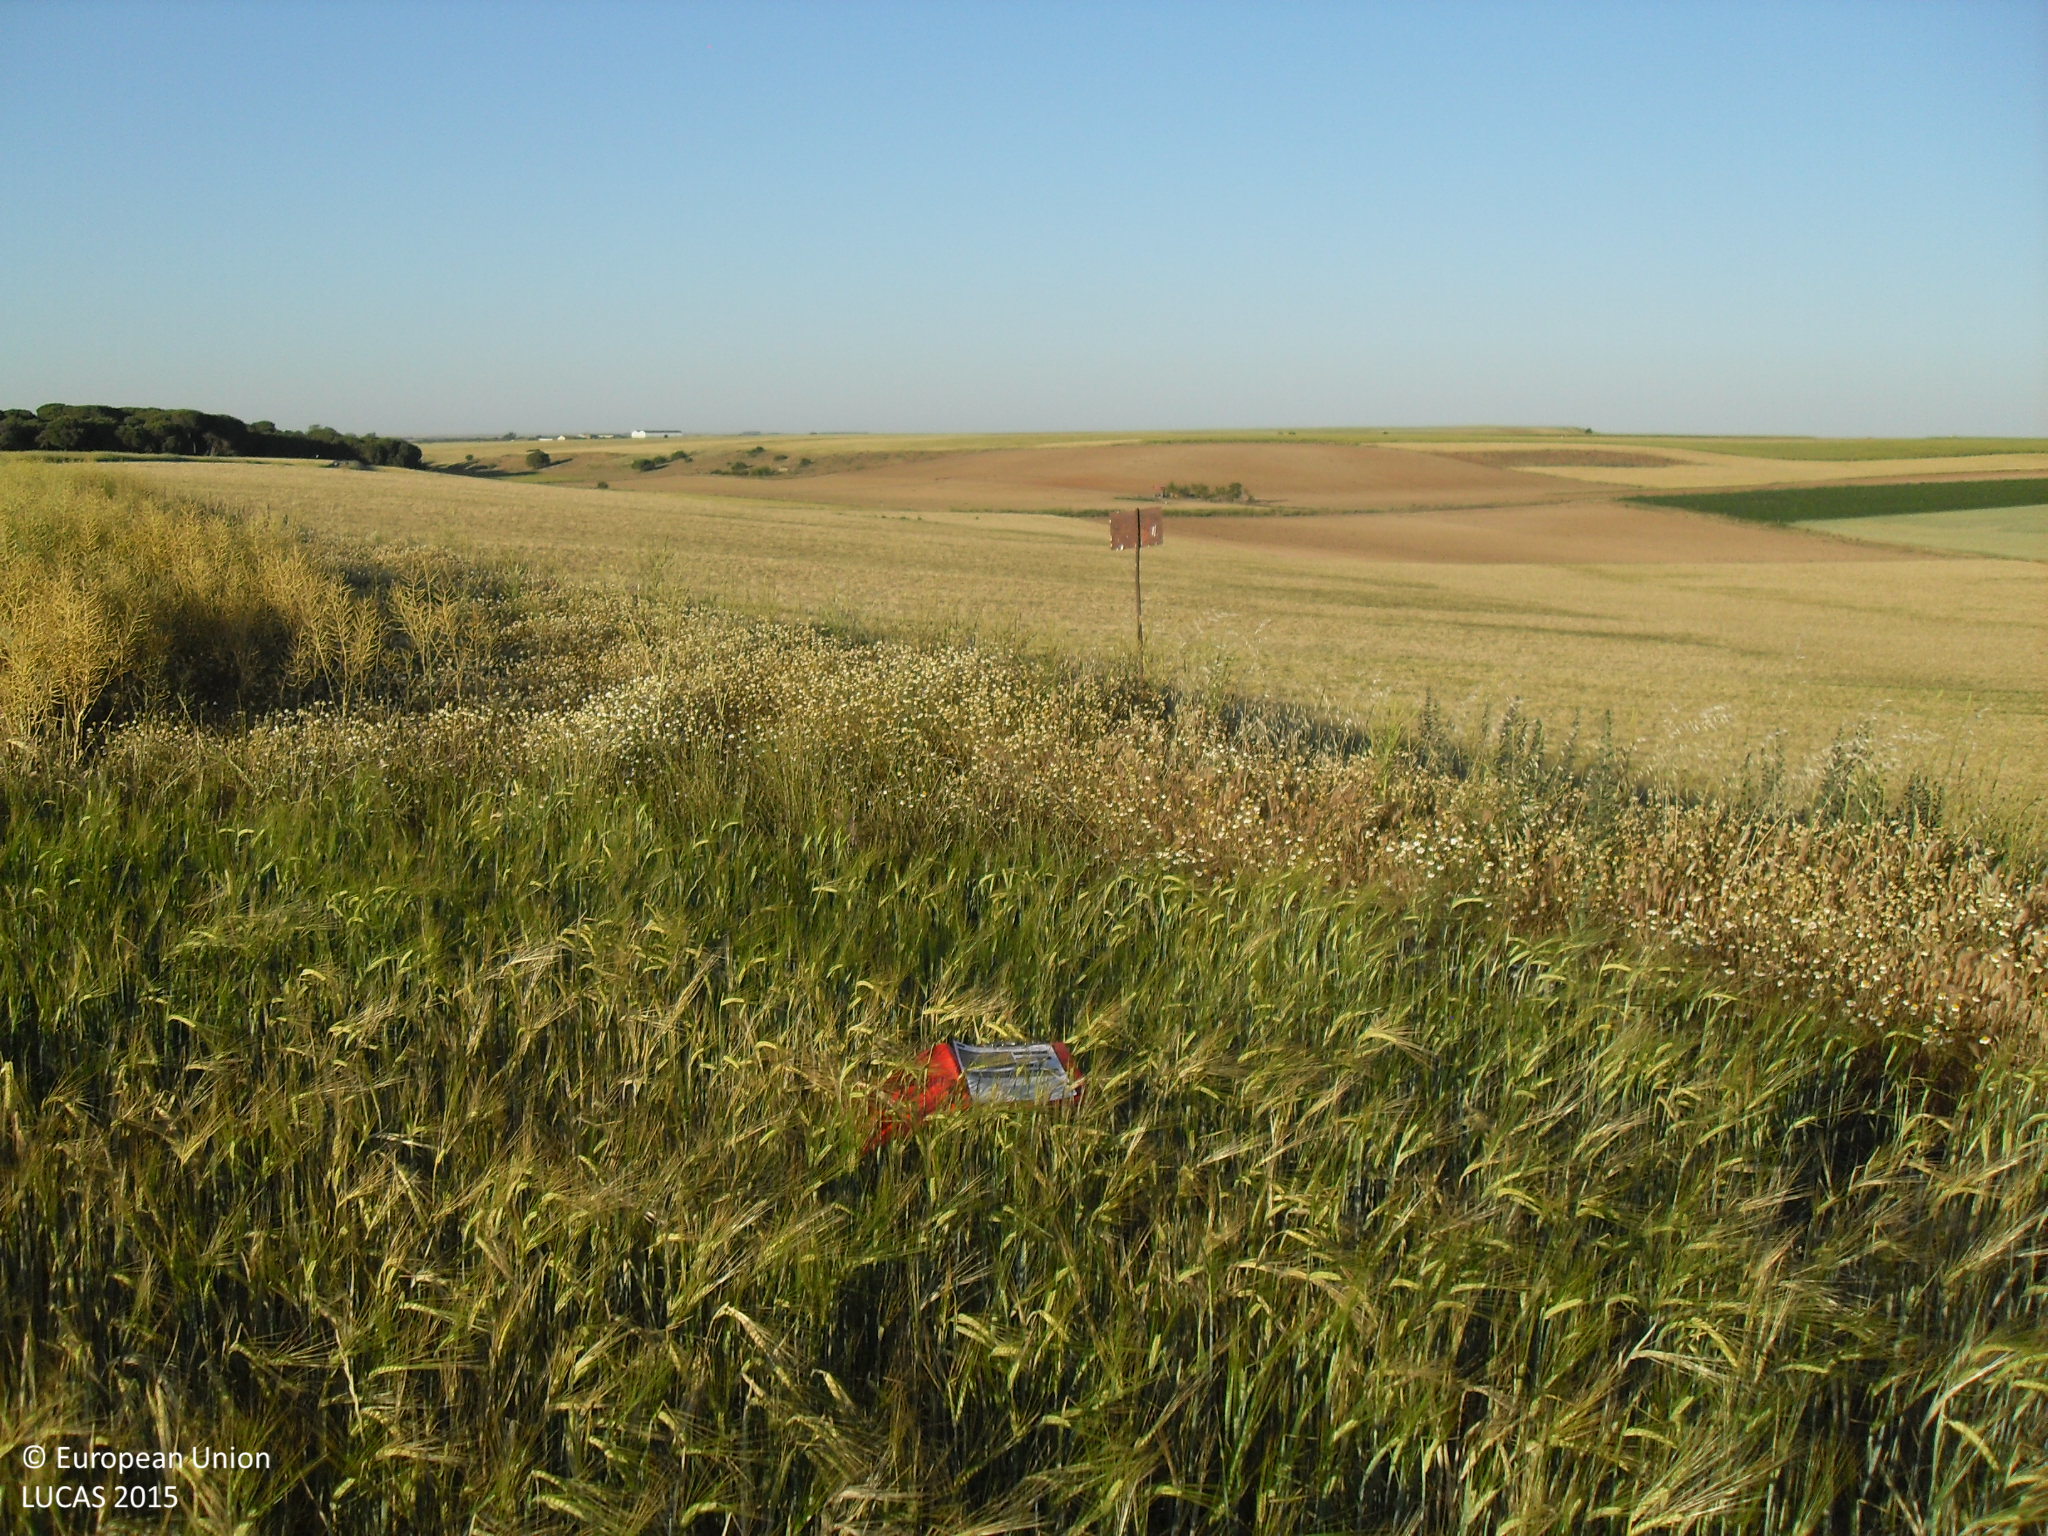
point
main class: Cropland
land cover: Barley
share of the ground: > 75 %
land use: Agriculture (excluding fallow land and kitchen gardens)
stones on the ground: 25 - 50 %
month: May
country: ES
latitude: 41.0659
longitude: -5.3891
